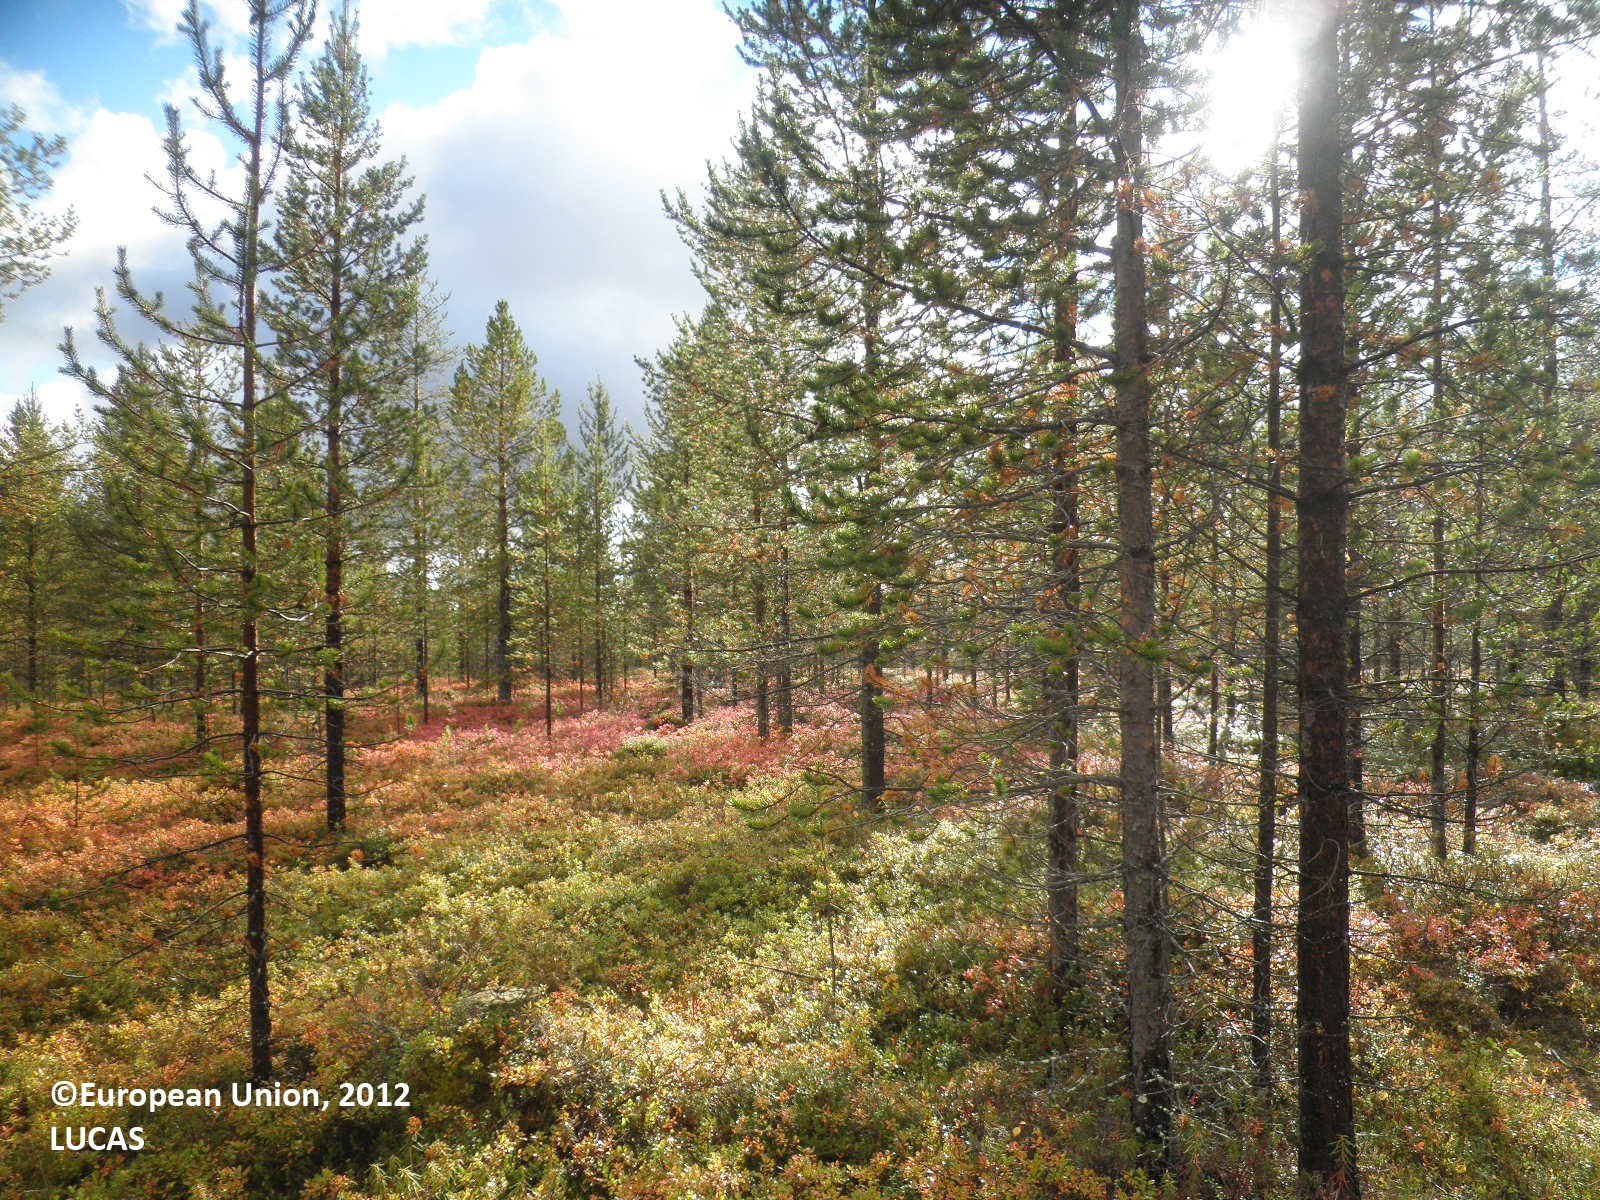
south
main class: Woodland
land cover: Pine dominated coniferous woodland
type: boreal forest
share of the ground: 25 - 50 %
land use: Forestry
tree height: > 5 m
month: September
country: FI
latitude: 67.6731
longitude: 28.6960
